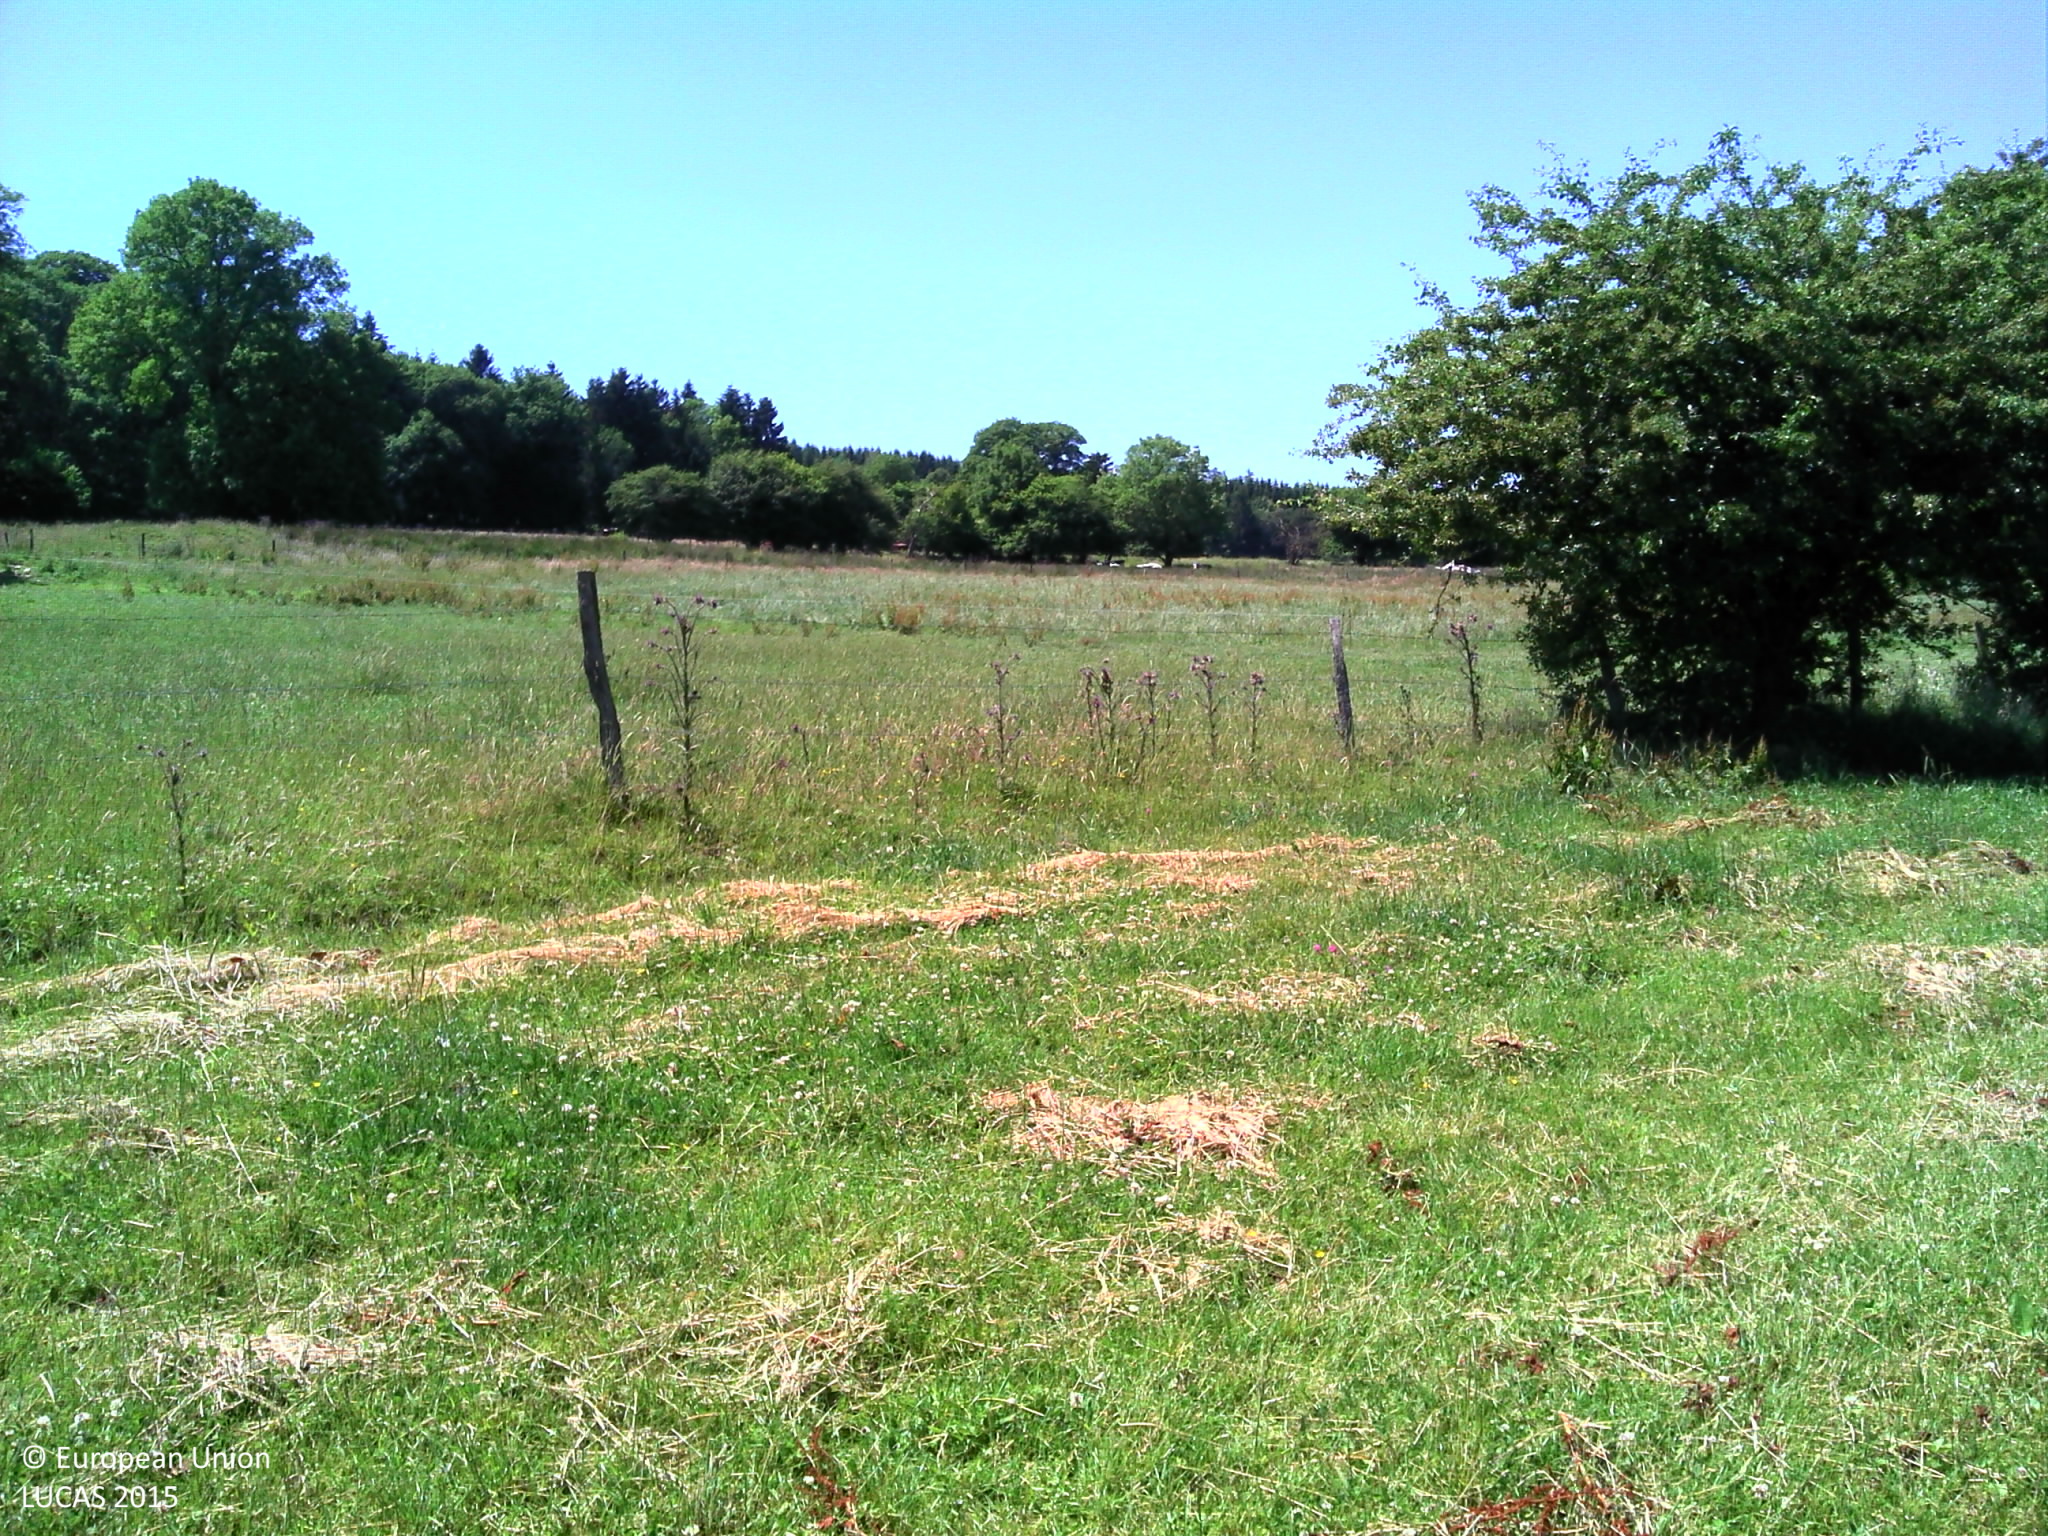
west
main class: Grassland
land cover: Grassland without tree/shrub cover
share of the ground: > 75 %
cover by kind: herbaceous plants 100 %
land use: Agriculture (excluding fallow land and kitchen gardens)
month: June
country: BE
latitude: 50.0421
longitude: 5.5161
